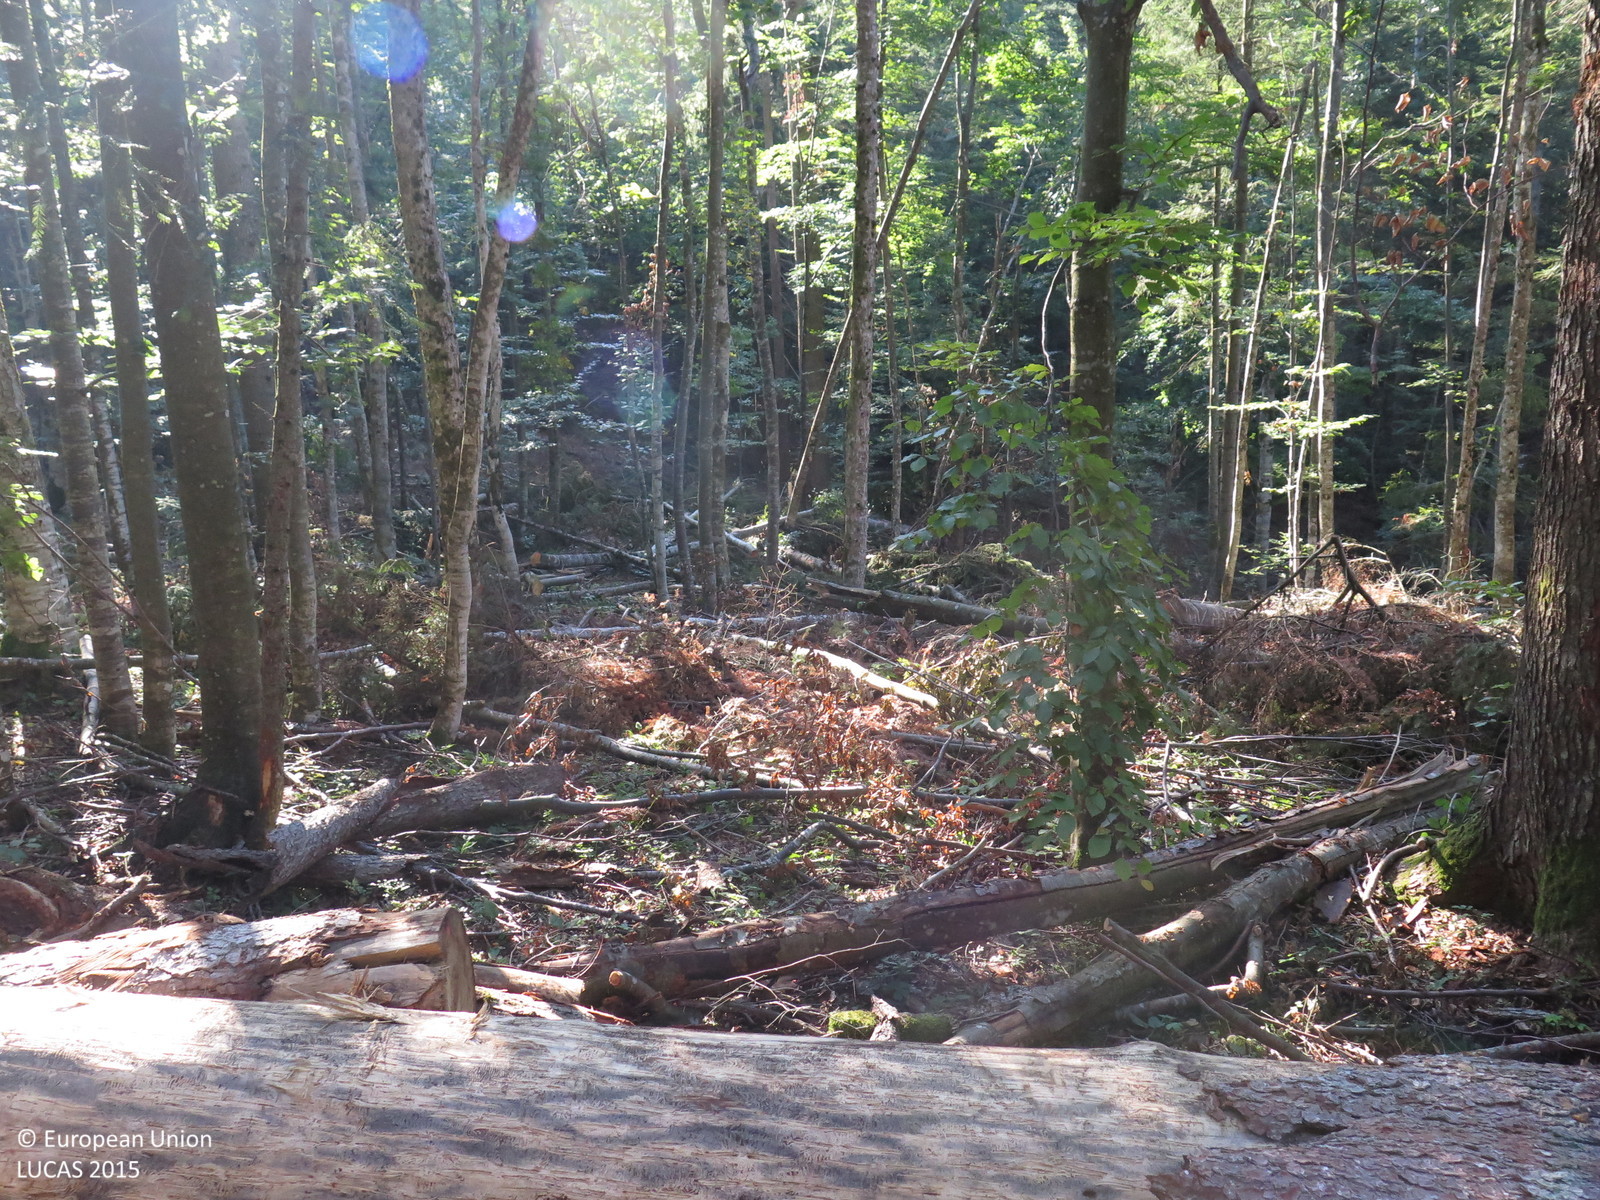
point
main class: Woodland
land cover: Other mixed woodland
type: mountainous beech forest
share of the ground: > 75 %
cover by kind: broadleaved forest trees 75 %, coniferous forest trees 25 %
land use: Forestry
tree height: > 5 m
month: September
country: HR
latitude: 45.5488
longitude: 14.5938
